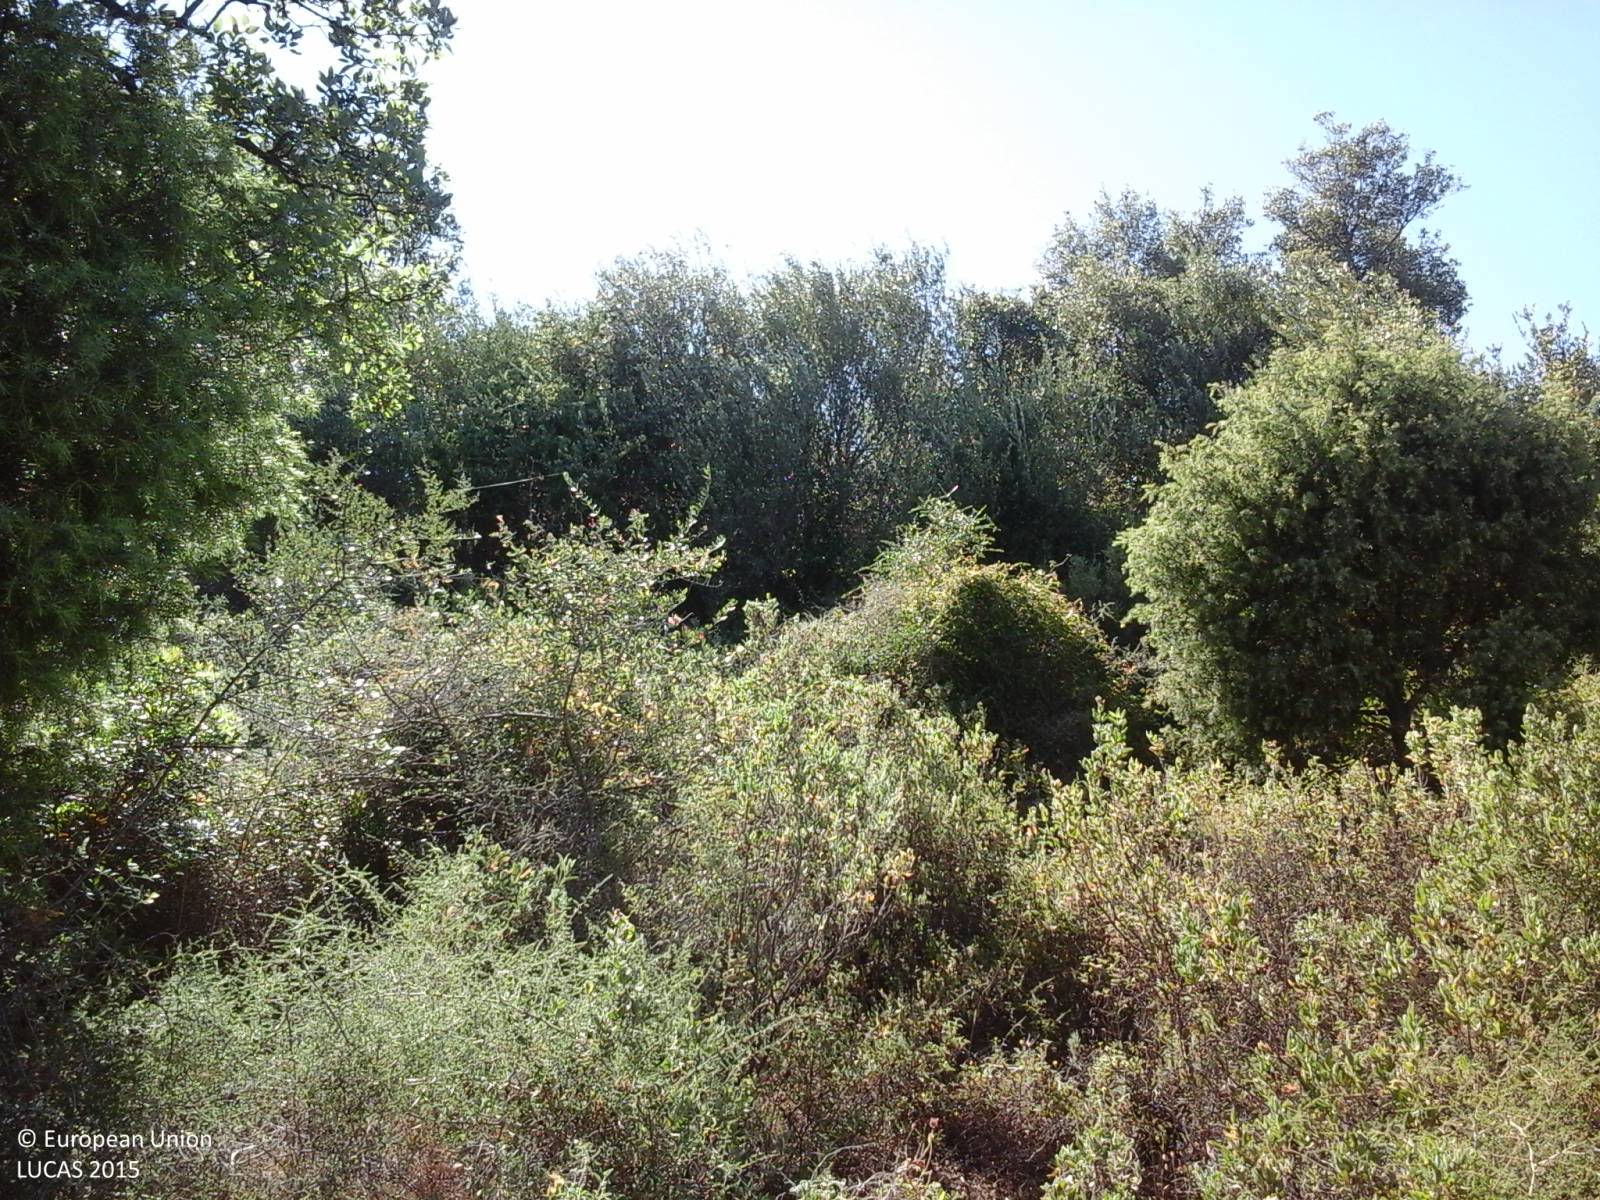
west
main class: Shrubland
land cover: Shrubland without tree cover
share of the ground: > 75 %
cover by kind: shrubs 95 %, herbaceous plants 5 %
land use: Semi-natural and natural areas not in use
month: May
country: IT
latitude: 40.3381
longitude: 9.4262
